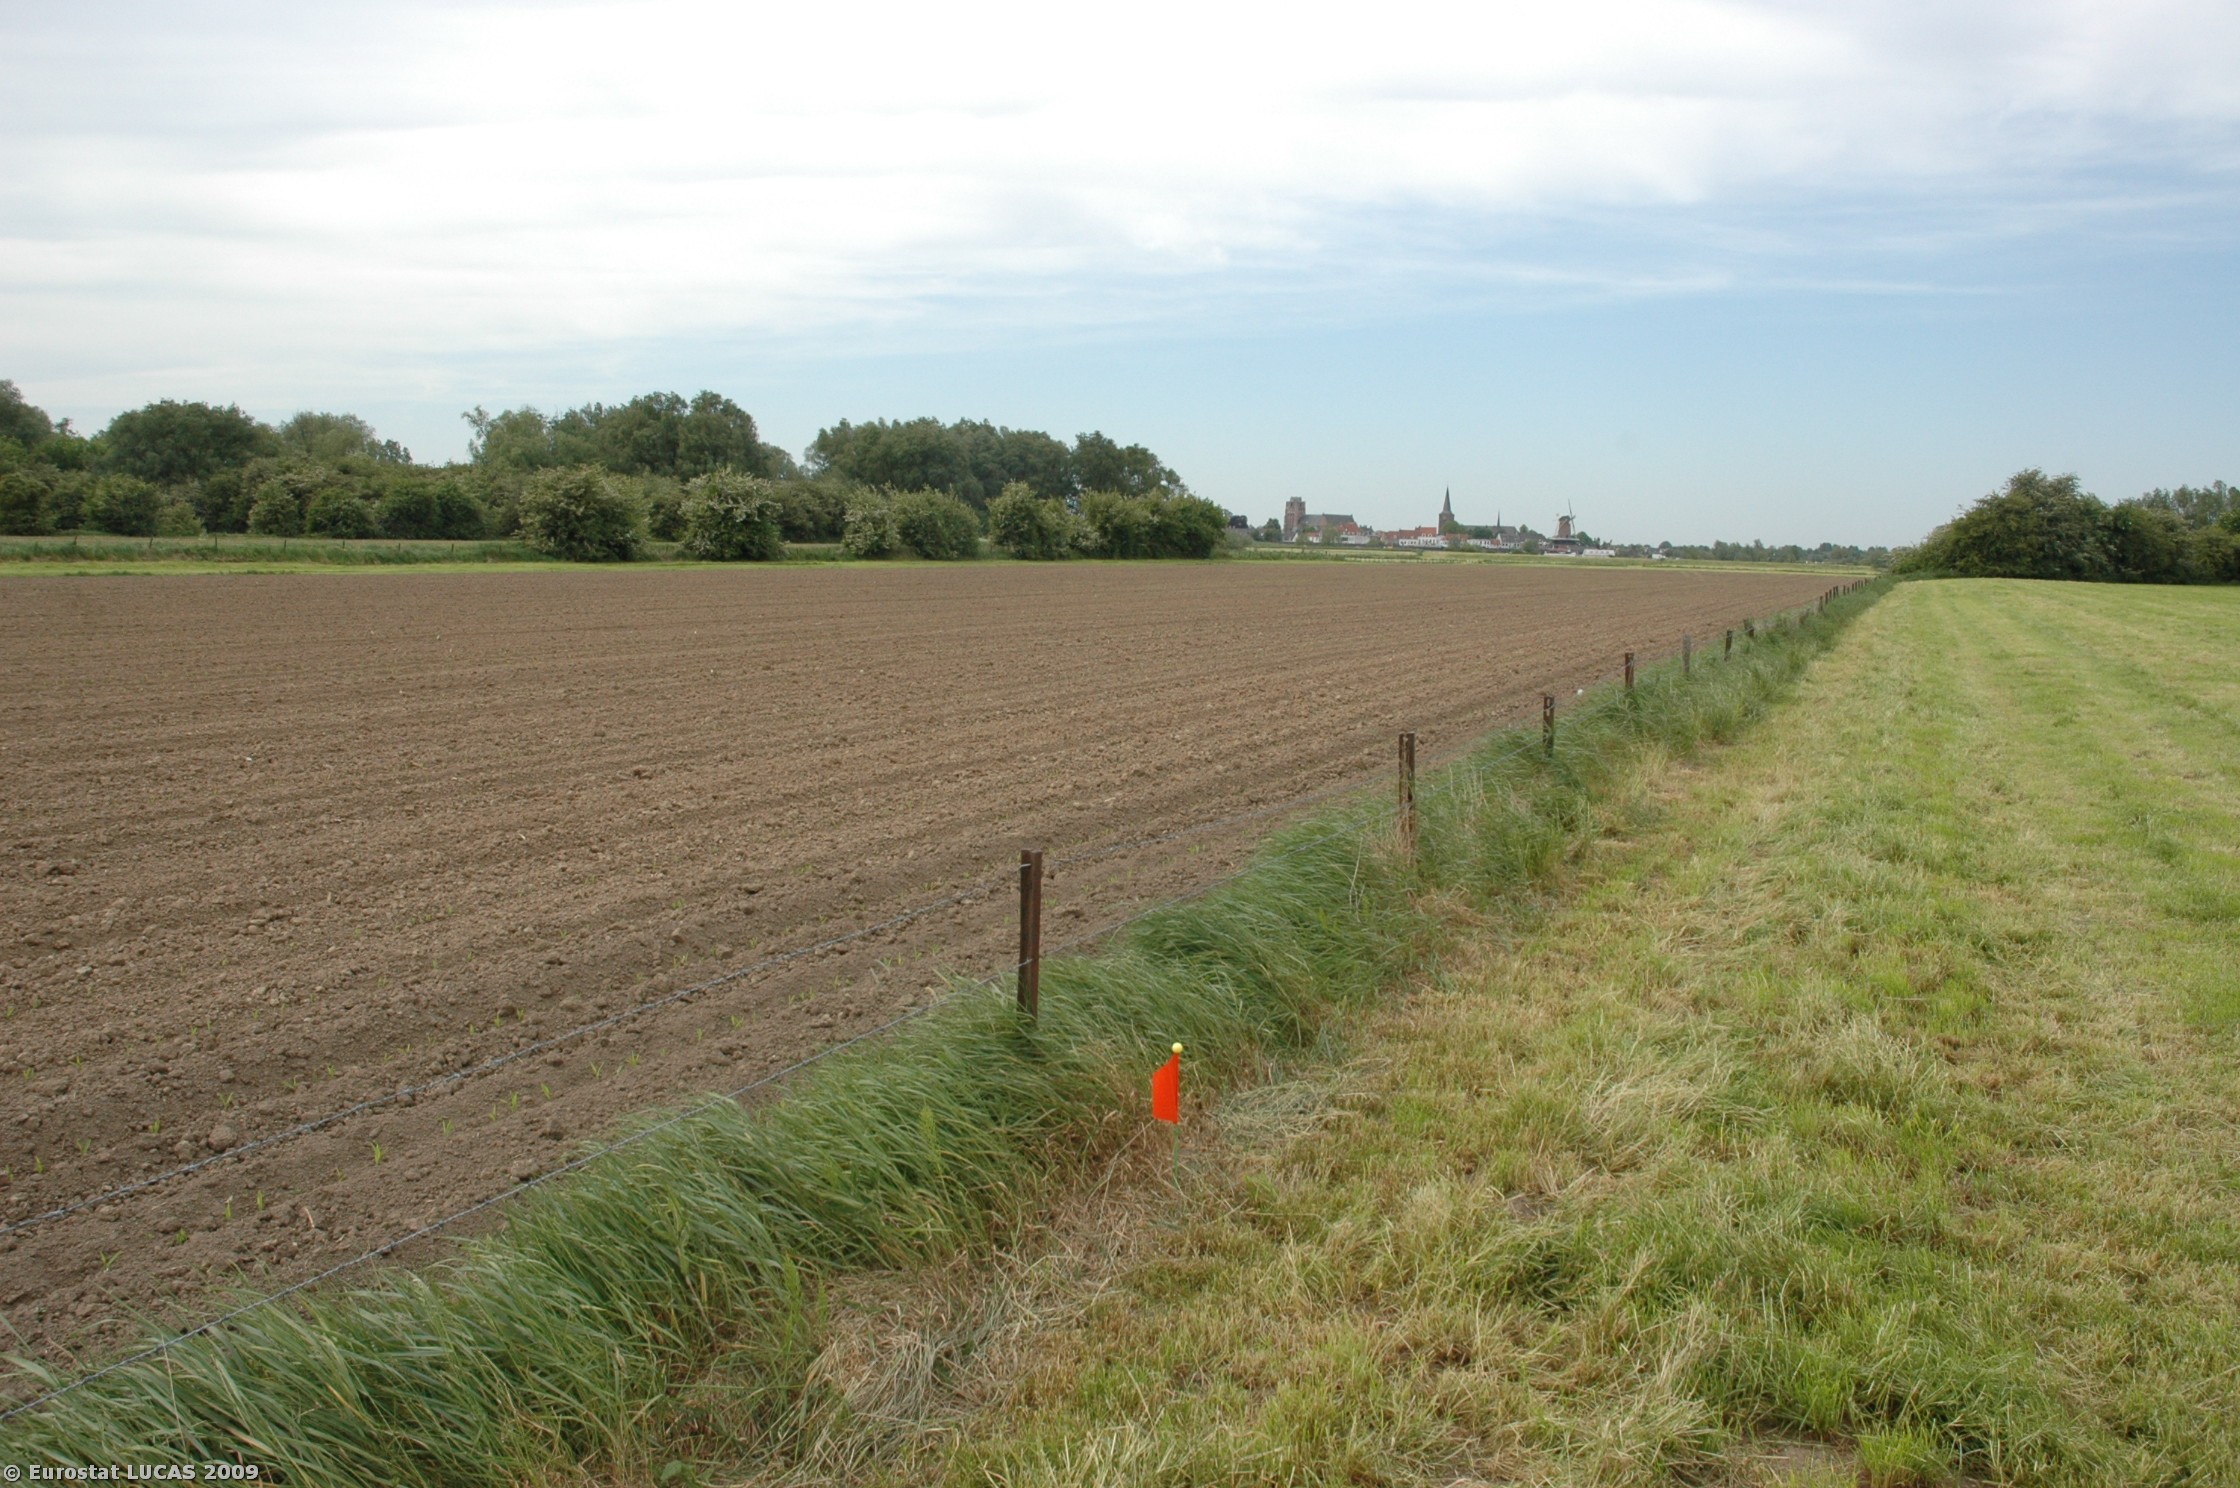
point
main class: Grassland
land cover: Grassland without tree/shrub cover
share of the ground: > 75 %
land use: Agriculture (excluding fallow land and kitchen gardens)
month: May
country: NL
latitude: 51.9626
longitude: 5.3554
